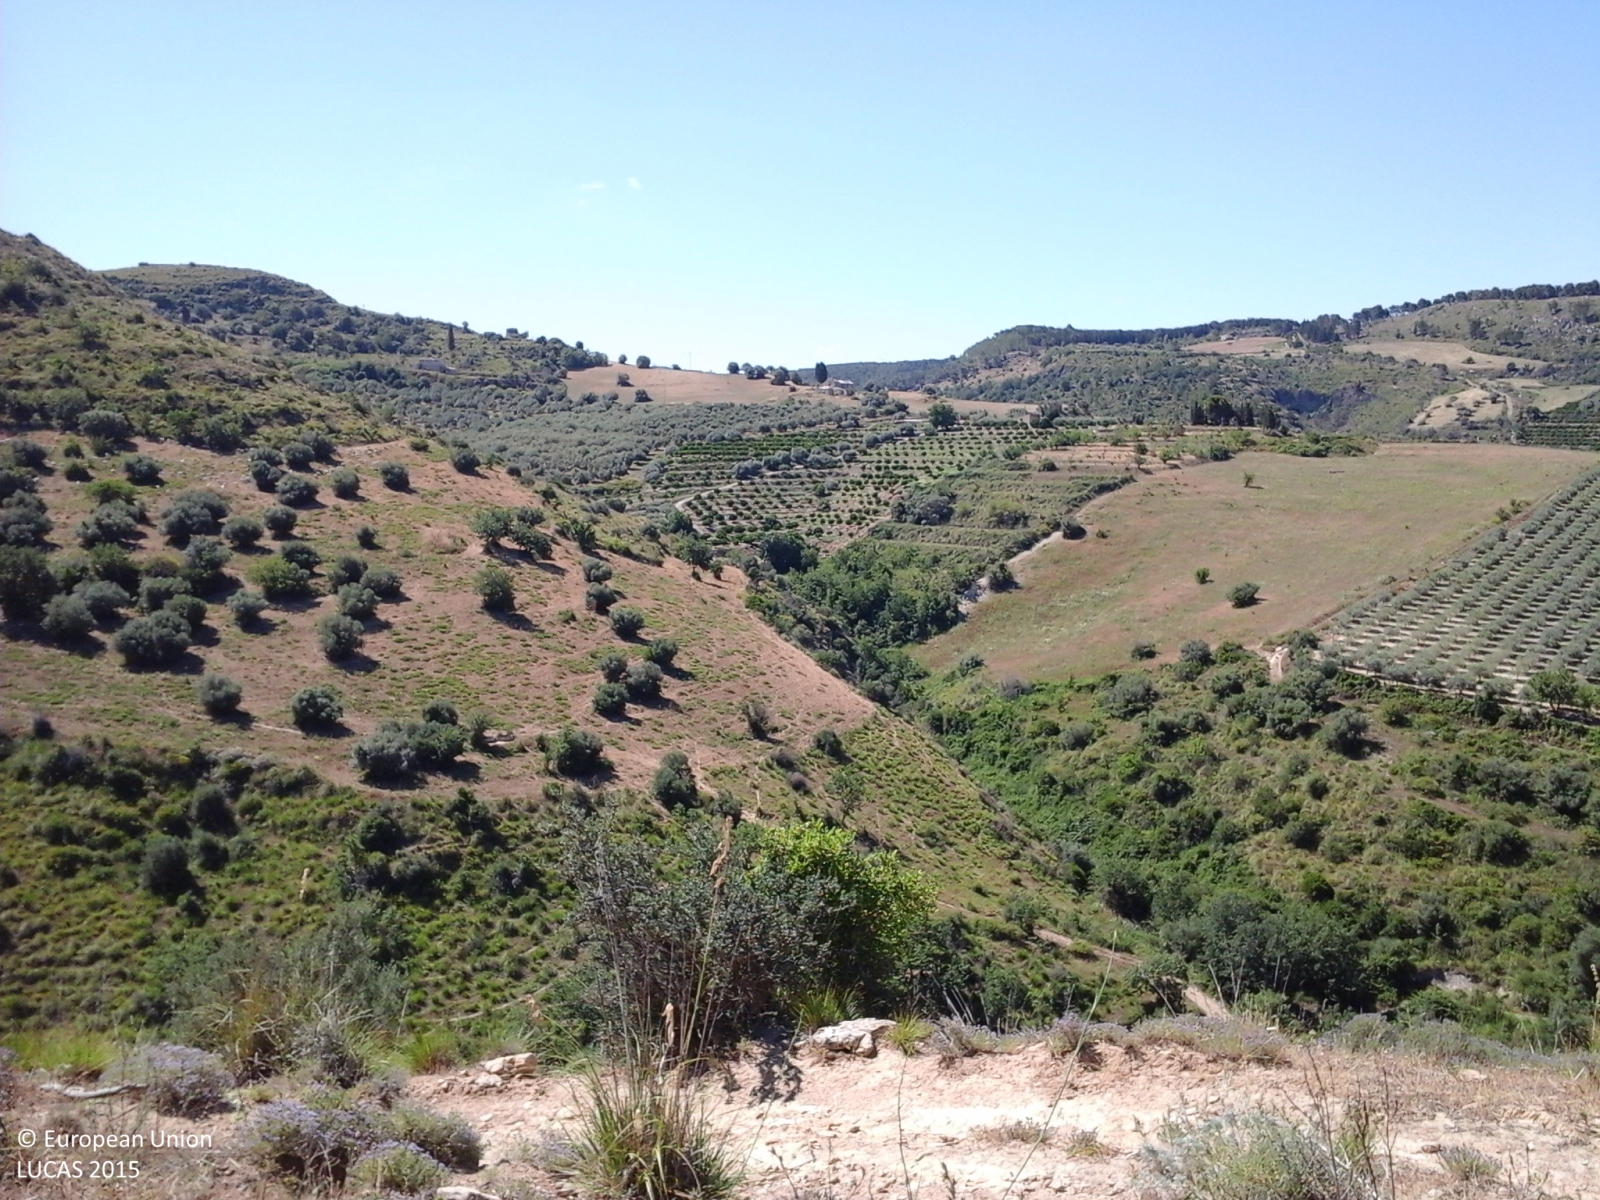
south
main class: Cropland
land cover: Other leguminous and mixtures for fodder
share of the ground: > 75 %
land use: Agriculture (excluding fallow land and kitchen gardens)
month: June
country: IT
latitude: 37.2511
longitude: 14.6660
